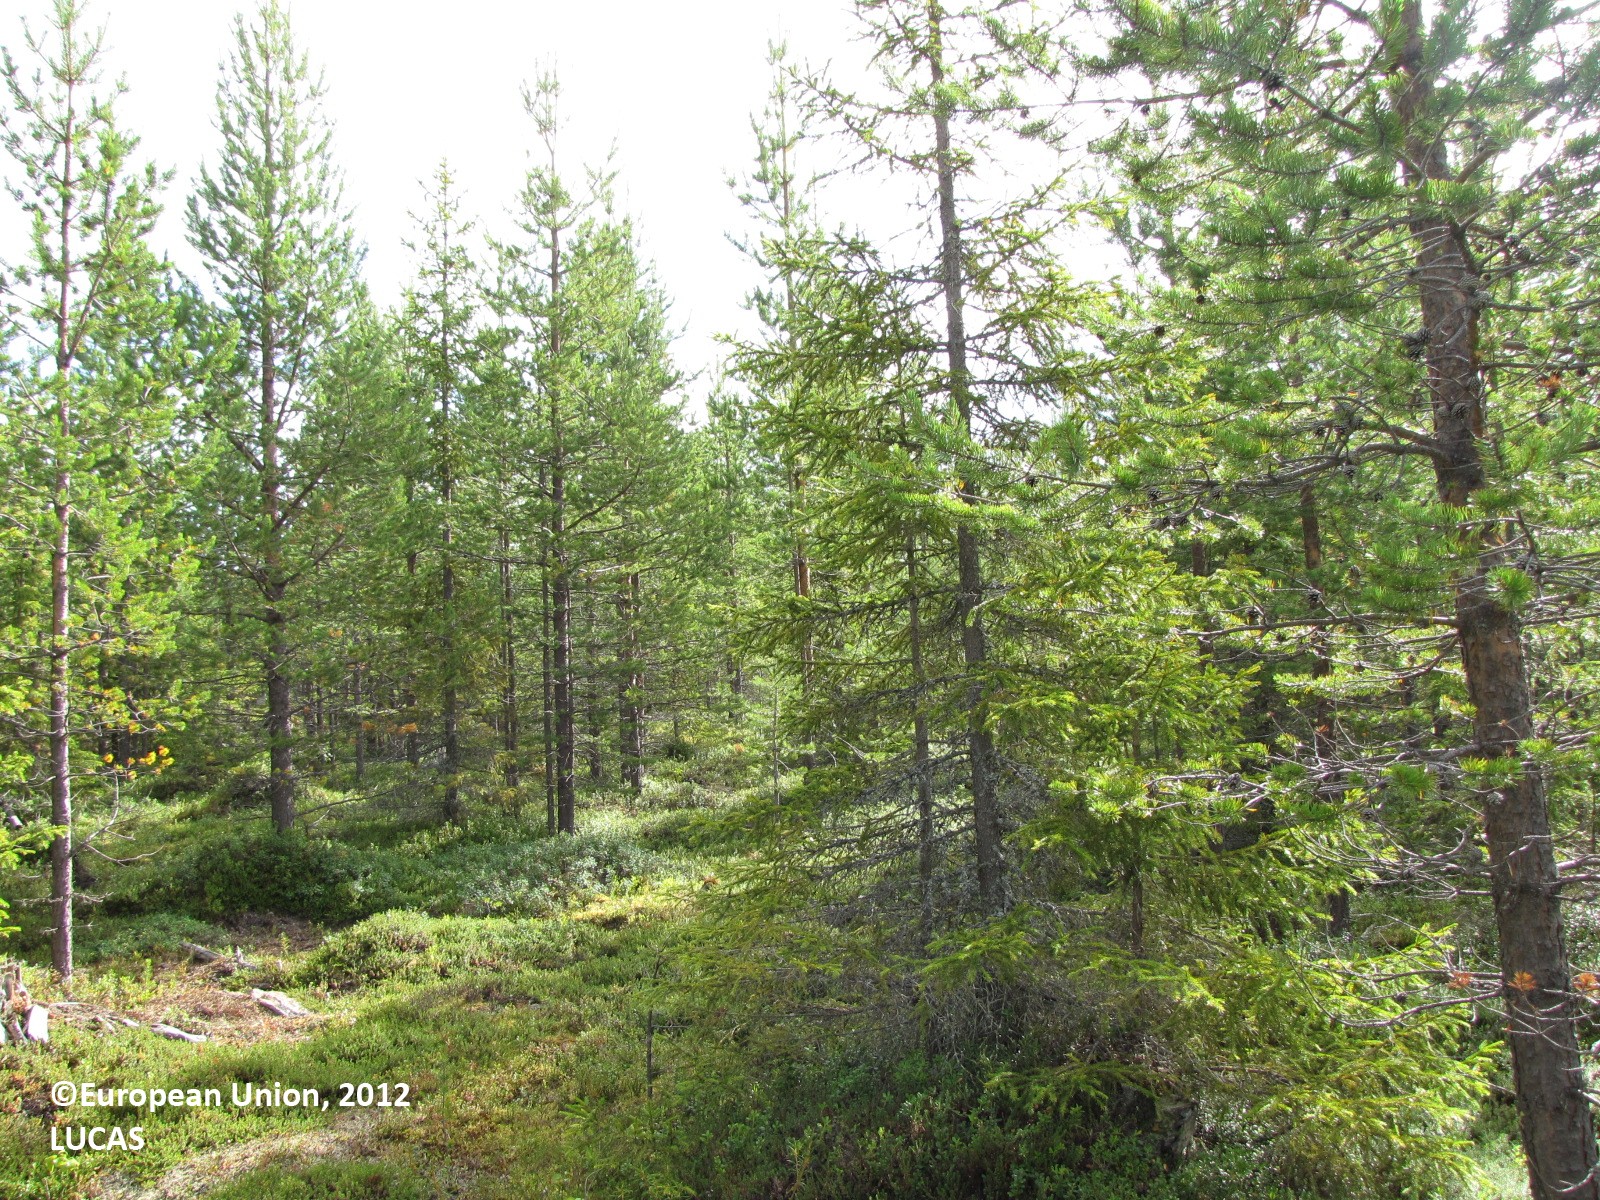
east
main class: Woodland
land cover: Pine dominated coniferous woodland
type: boreal forest
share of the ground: 25 - 50 %
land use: Forestry
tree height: > 5 m
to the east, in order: Pine dominated coniferous woodland; Paved roads, cycling and walking lanes; Abandoned hedges; Ditches and canals; Pine dominated coniferous woodland; Tracks; Pine dominated coniferous woodland; Tracks; Pine dominated coniferous woodland
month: August
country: FI
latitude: 66.8913
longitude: 24.6317
